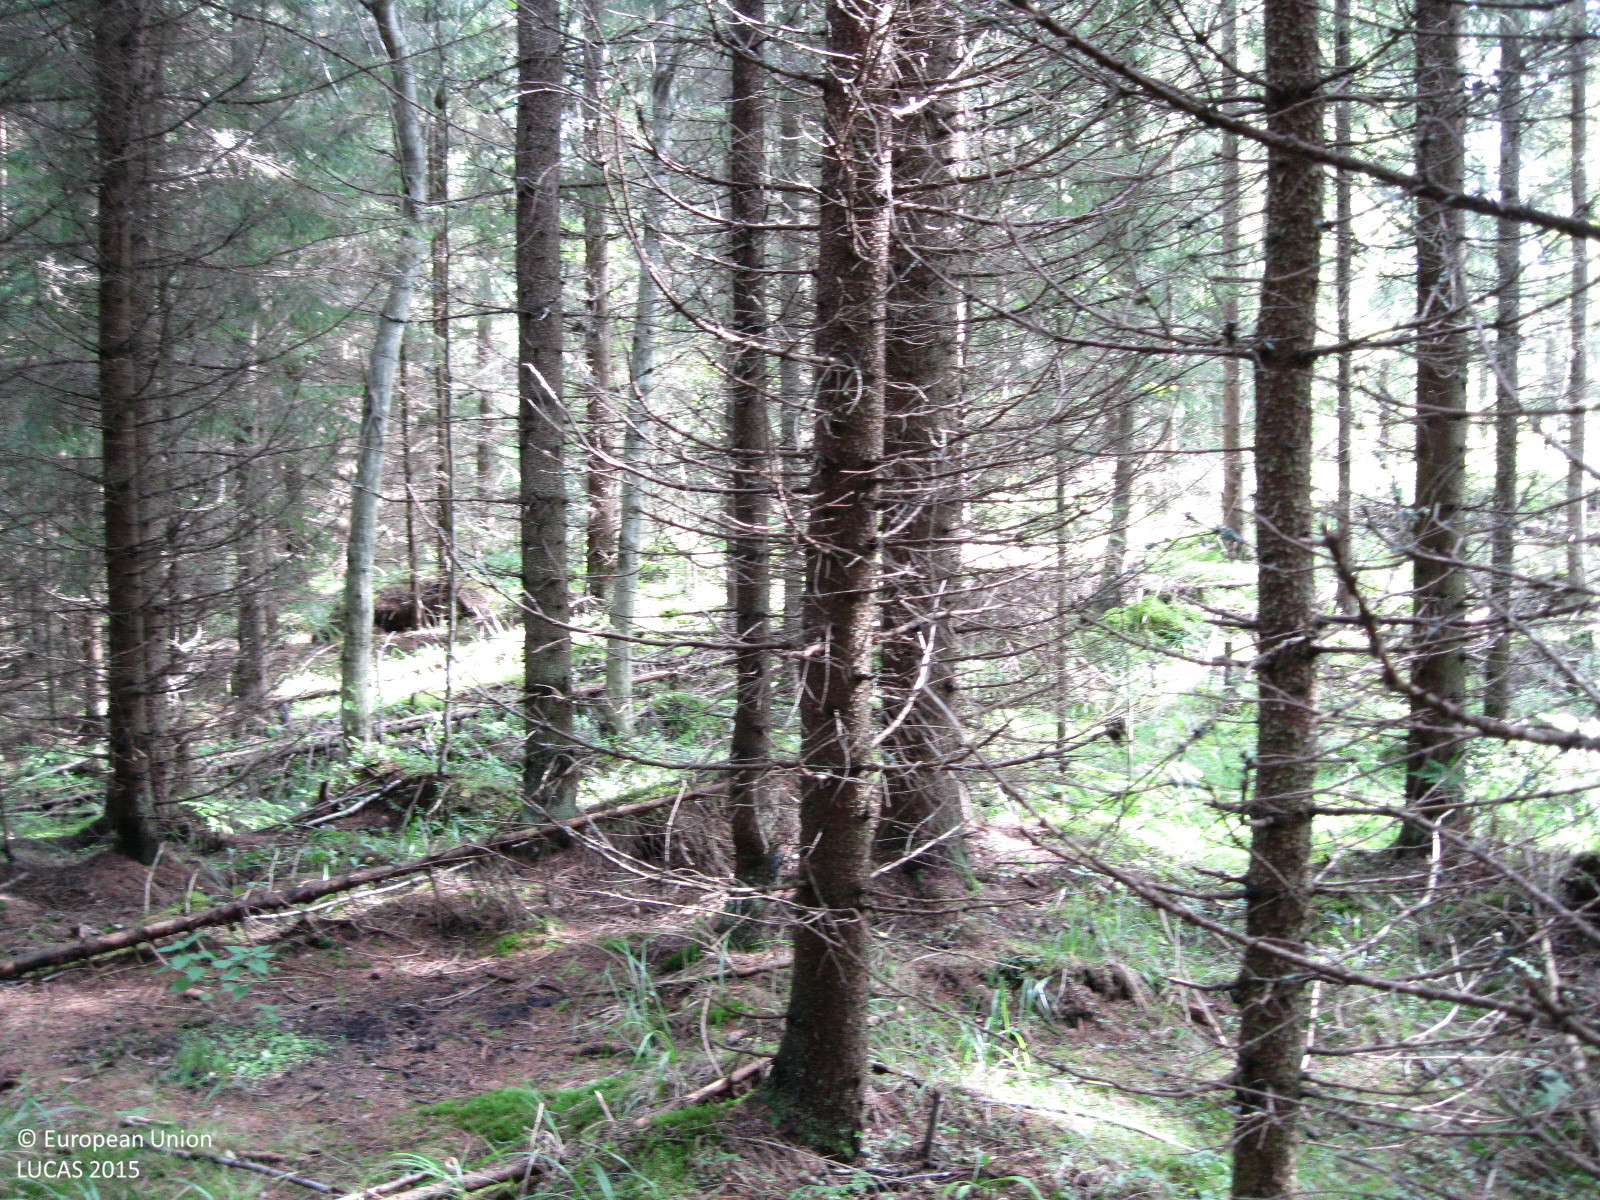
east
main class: Woodland
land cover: Spruce dominated coniferous woodland
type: boreal forest
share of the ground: > 75 %
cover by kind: coniferous forest trees 85 %, lichens and mosses 10 %, herbaceous plants 5 %
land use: Forestry
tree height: > 5 m
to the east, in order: Spruce dominated coniferous woodland; Spruce dominated mixed woodland; Ditches and canals; Spruce dominated mixed woodland; Grassland with sparse tree/shrub cover; Tracks; Spontaneously vegetated surfaces; Other coniferous woodland
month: September
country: FI
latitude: 60.5287
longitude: 24.4826
